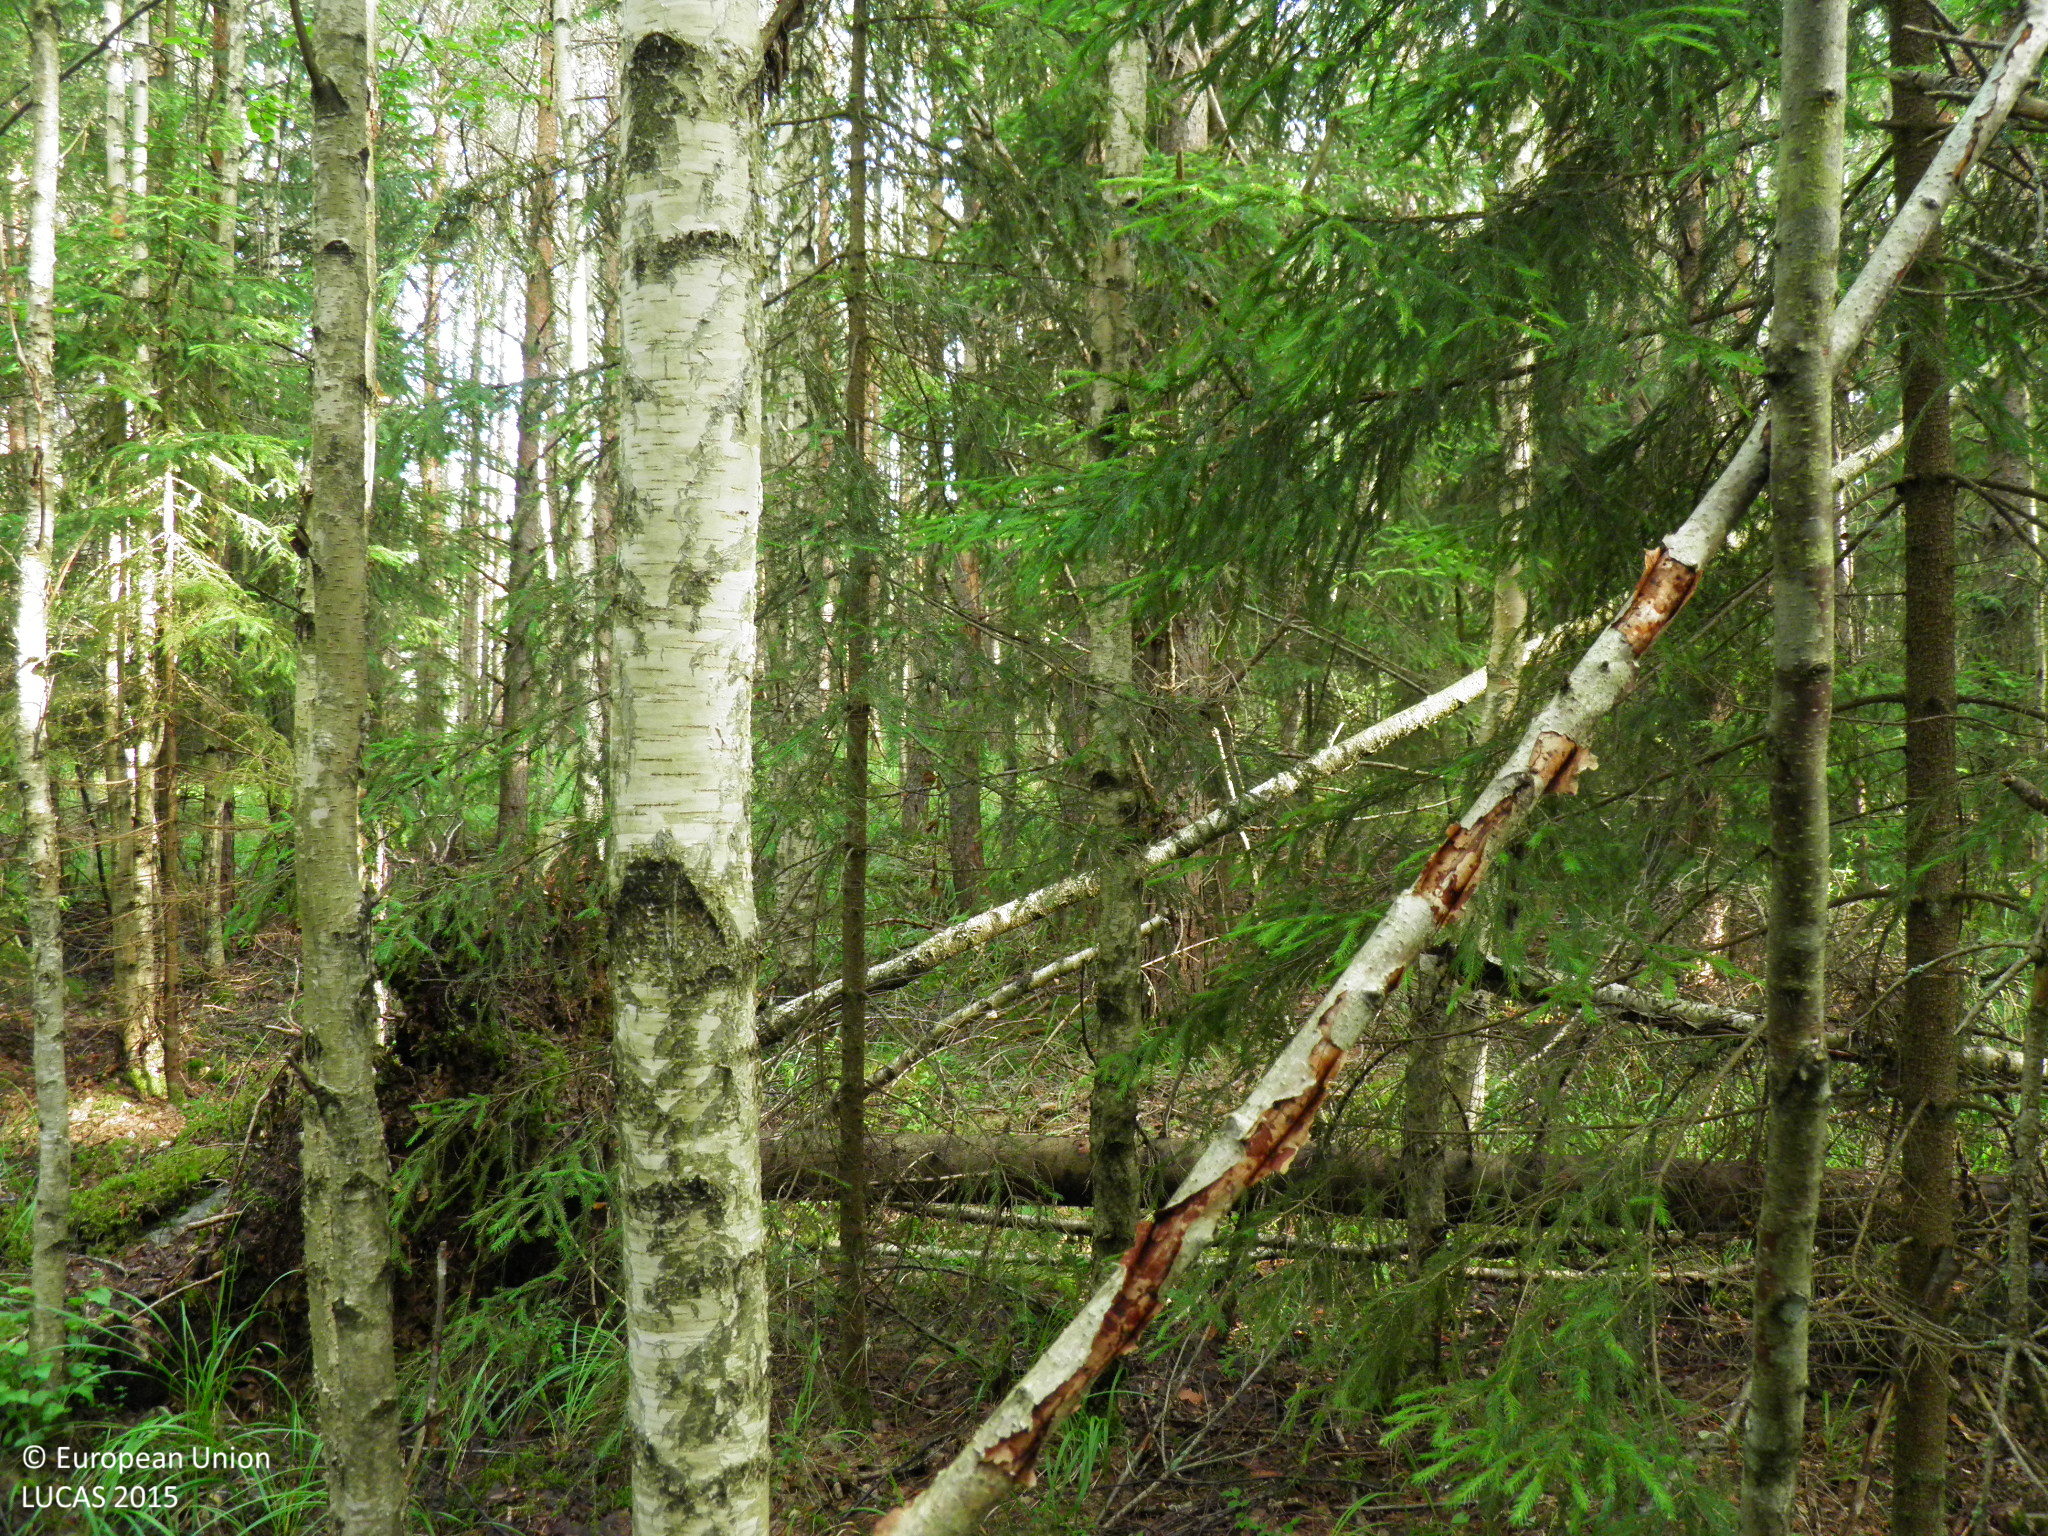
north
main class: Woodland
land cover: Pine dominated mixed woodland
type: hemiboreal forest and nemoral coniferous forest and mixed broadleaved-coniferous forest
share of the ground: > 75 %
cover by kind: broadleaved forest trees 50 %, coniferous forest trees 40 %, herbaceous plants 5 %, unconsolidated bare surface 5 %
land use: Semi-natural and natural areas not in use
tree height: > 5 m
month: July
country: FI
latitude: 60.7229
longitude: 22.4416
